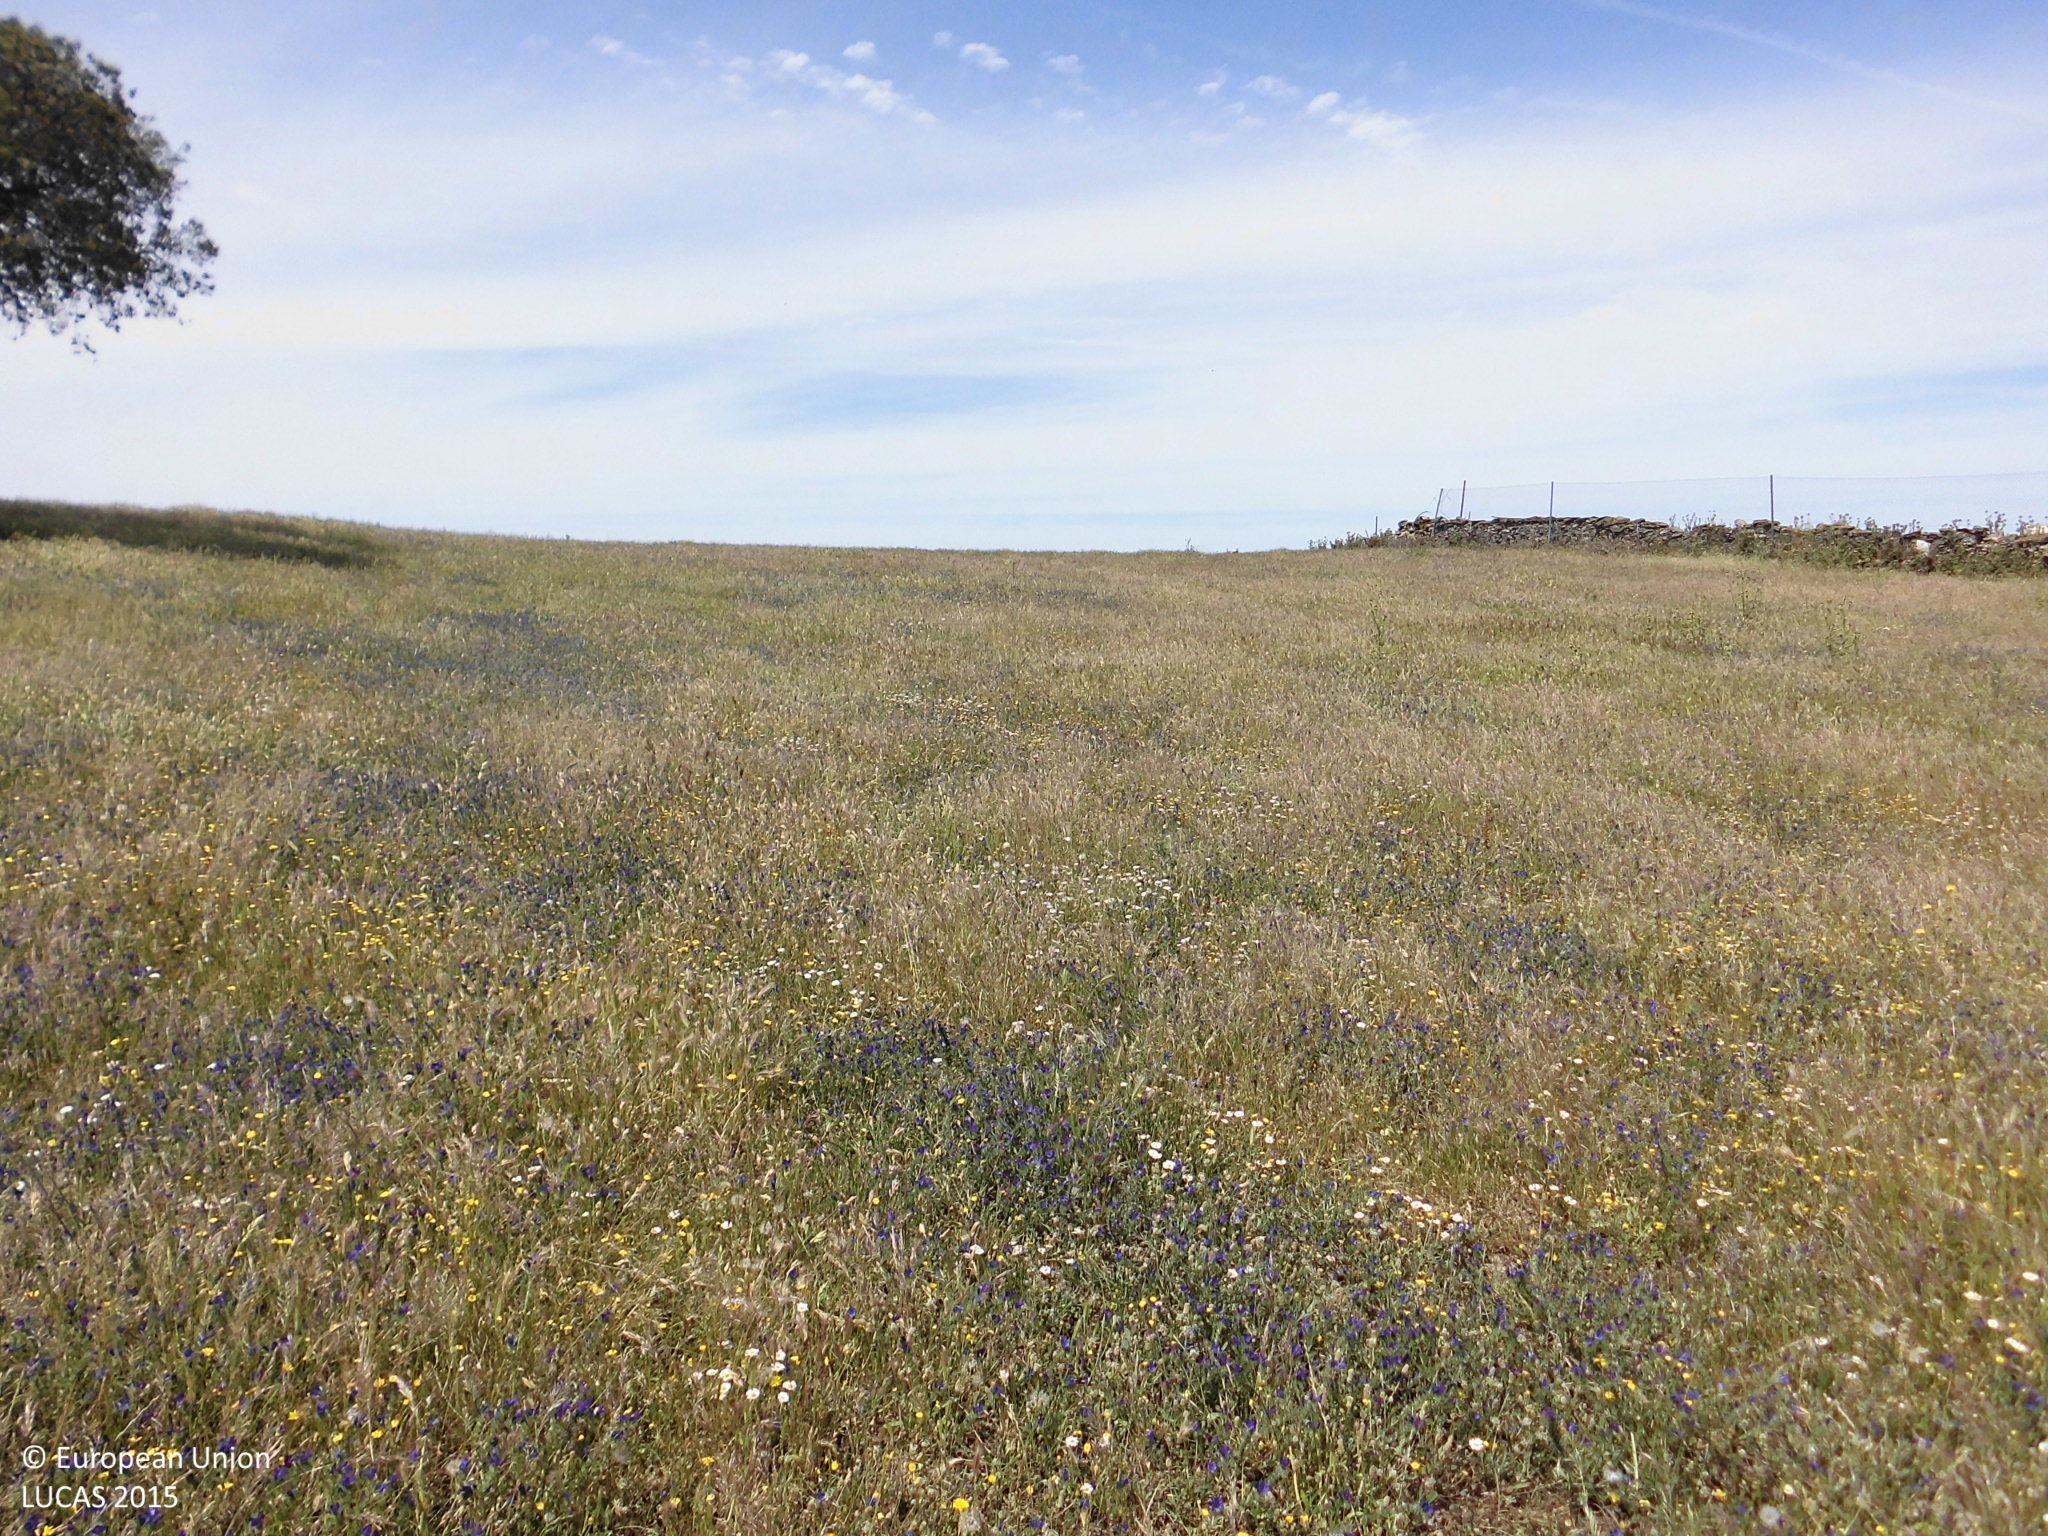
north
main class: Grassland
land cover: Grassland without tree/shrub cover
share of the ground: > 75 %
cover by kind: herbaceous plants 100 %
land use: Agriculture (excluding fallow land and kitchen gardens)
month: May
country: ES
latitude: 39.5368
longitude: -6.4172
